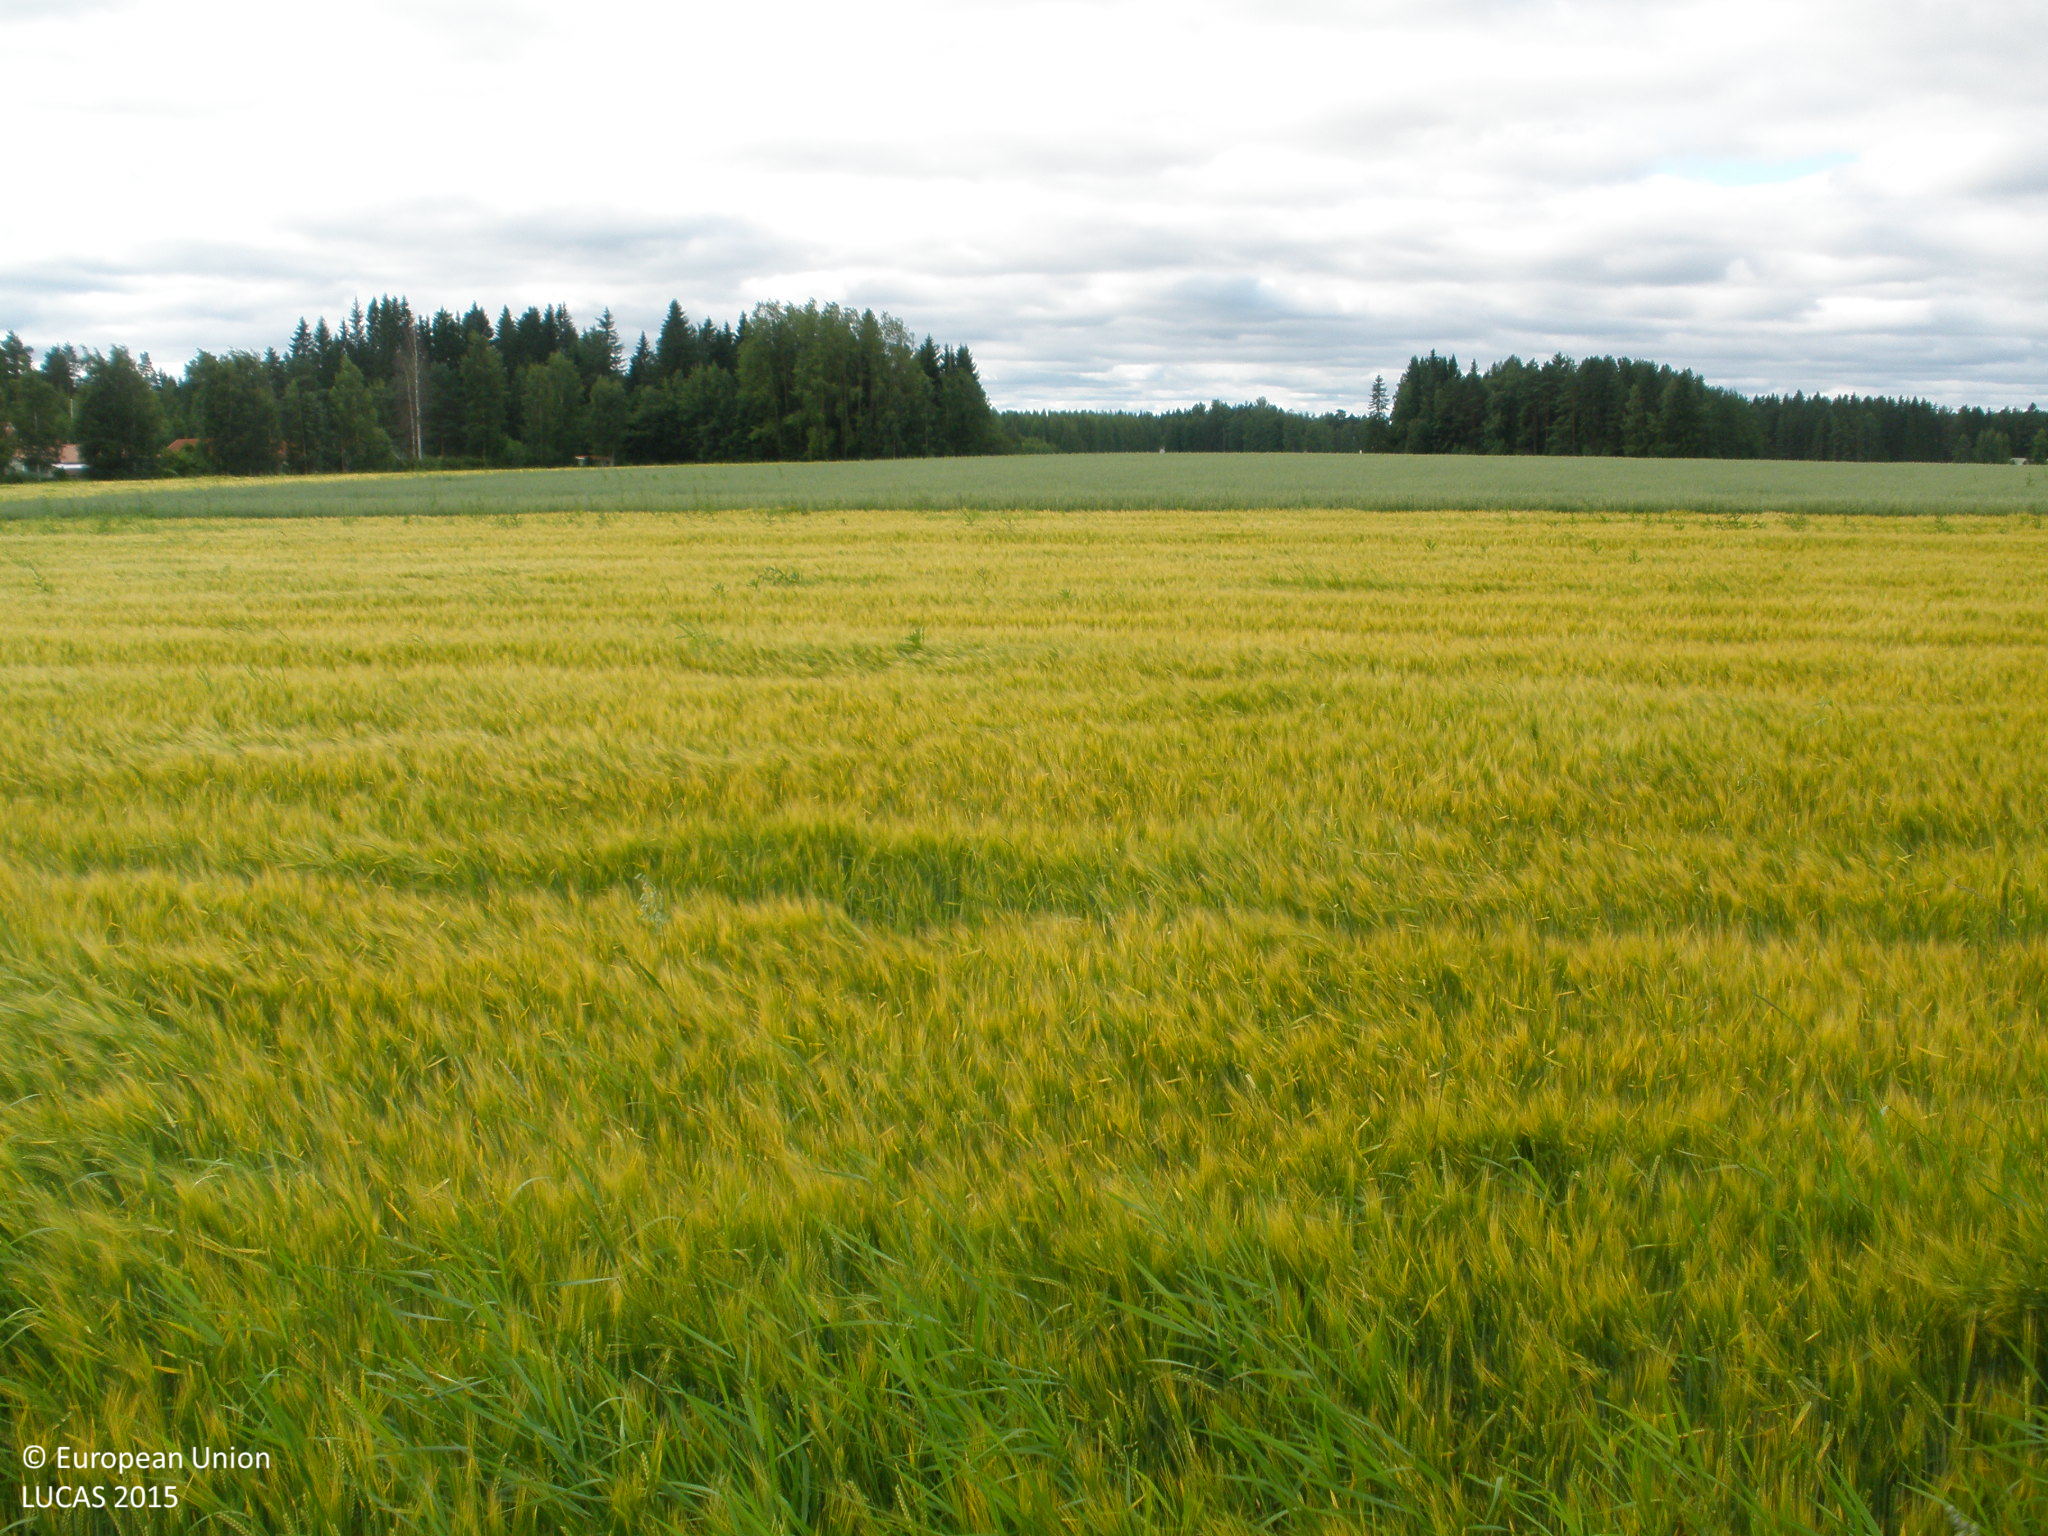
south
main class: Cropland
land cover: Oats
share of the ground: 50 - 75 %
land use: Agriculture (excluding fallow land and kitchen gardens)
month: August
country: FI
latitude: 60.9758
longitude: 24.4206
